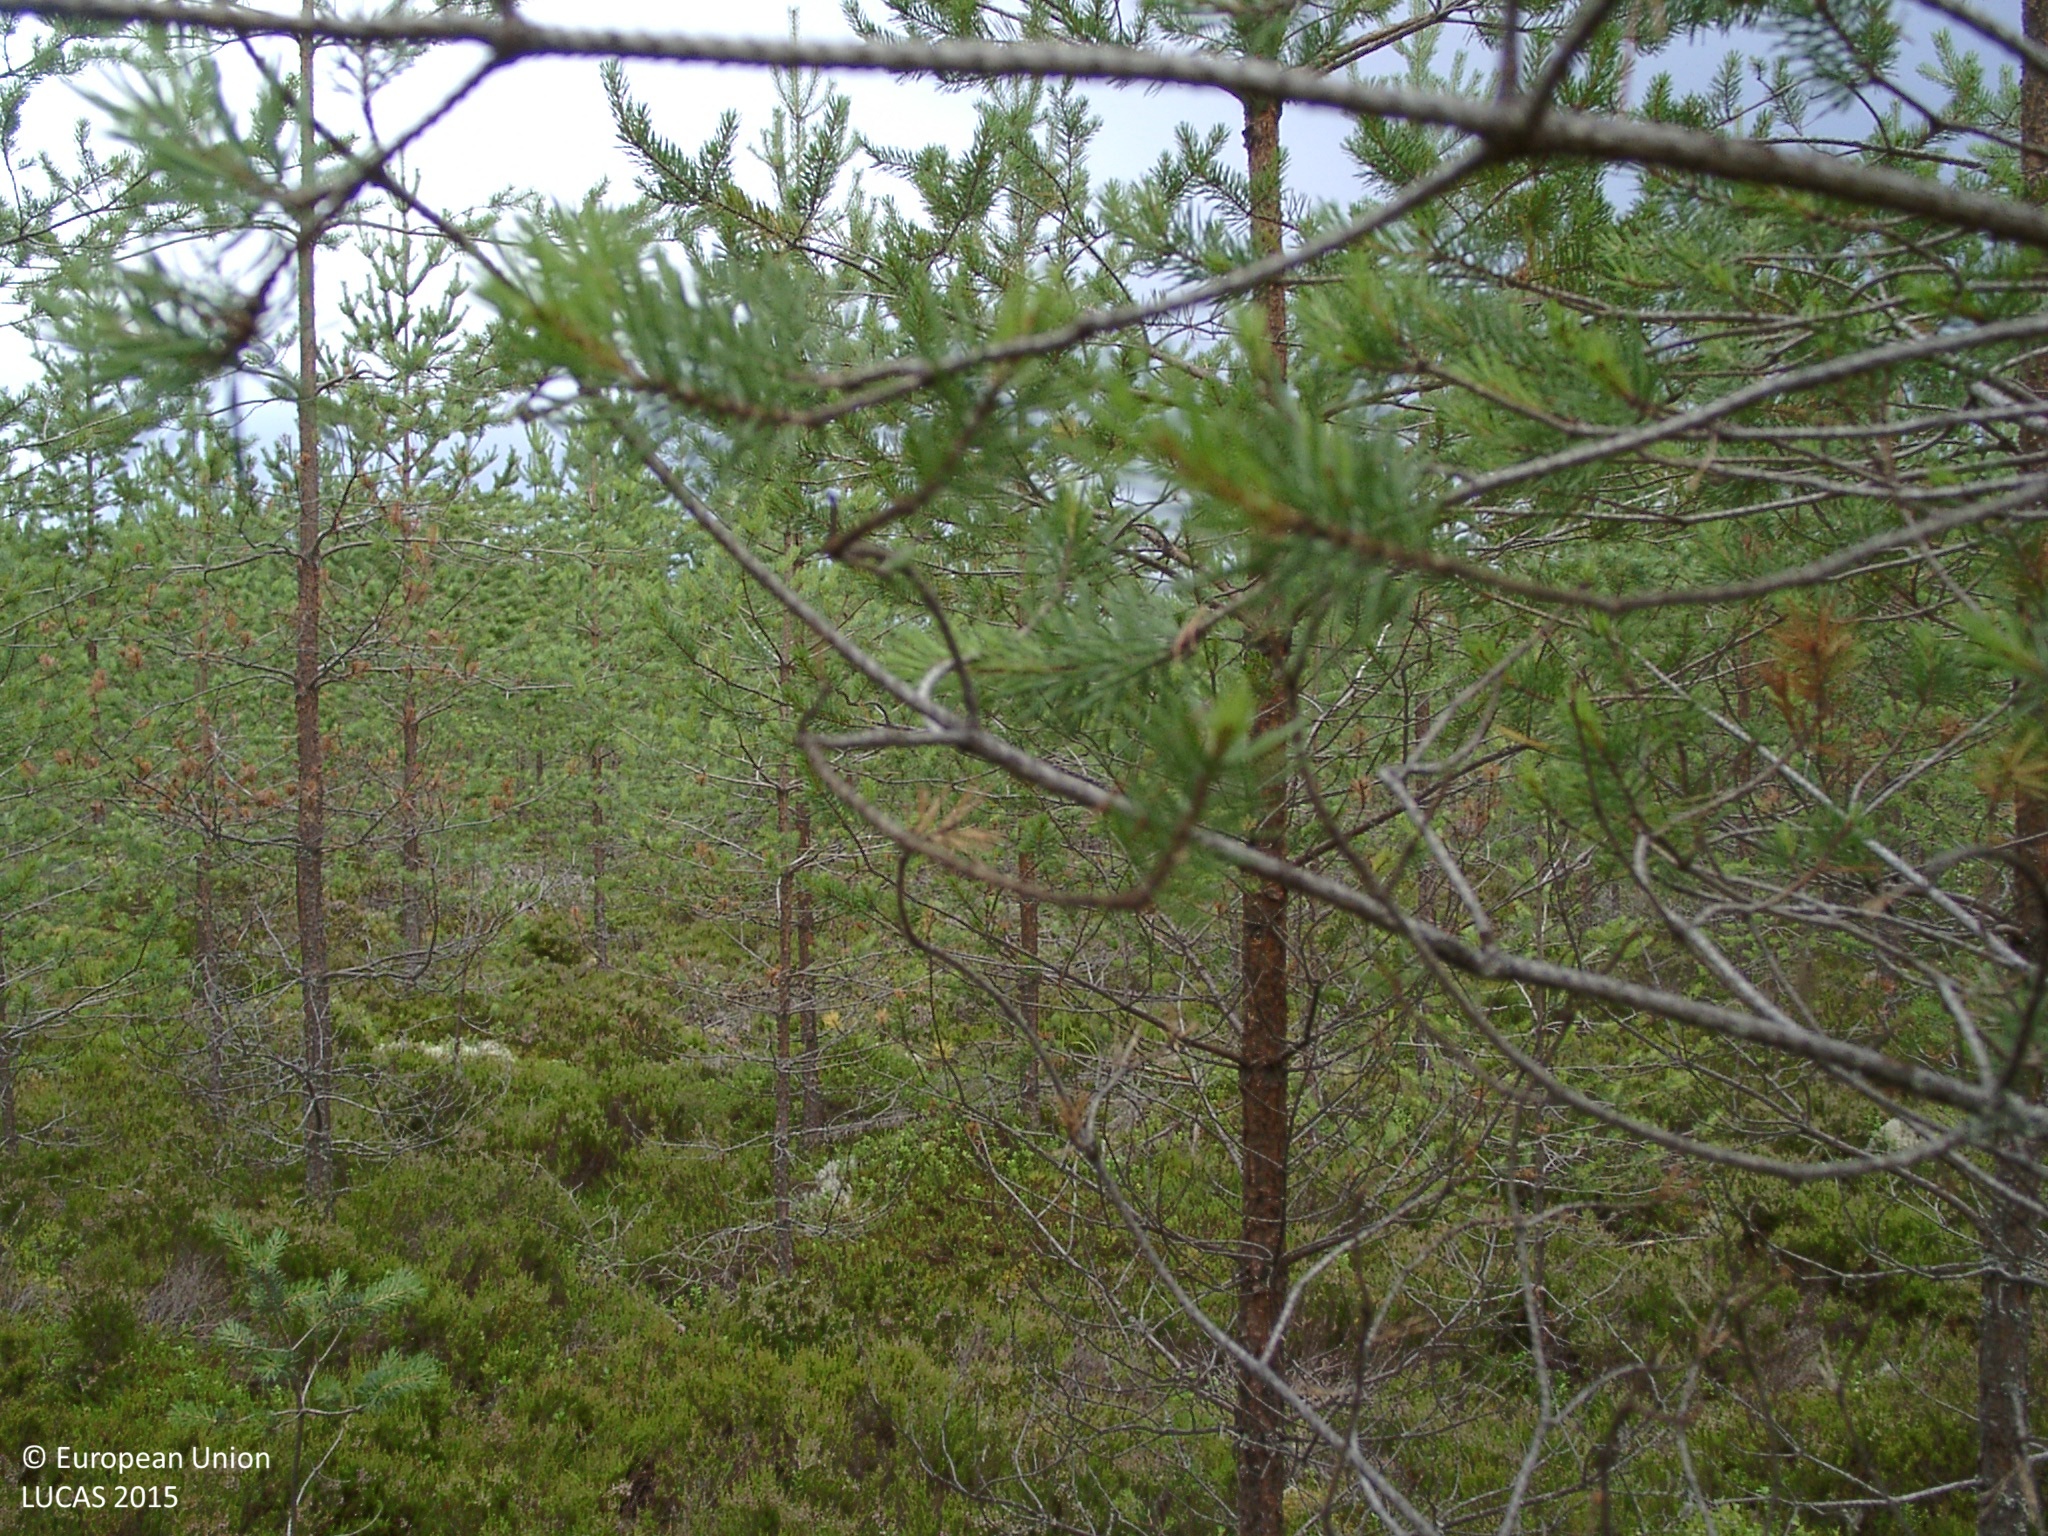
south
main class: Woodland
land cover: Pine dominated coniferous woodland
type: boreal forest
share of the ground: 50 - 75 %
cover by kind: coniferous forest trees 50 %, shrubs 35 %, lichens and mosses 15 %
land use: Forestry
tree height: < 5 m
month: July
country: FI
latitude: 62.7249
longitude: 24.5832
